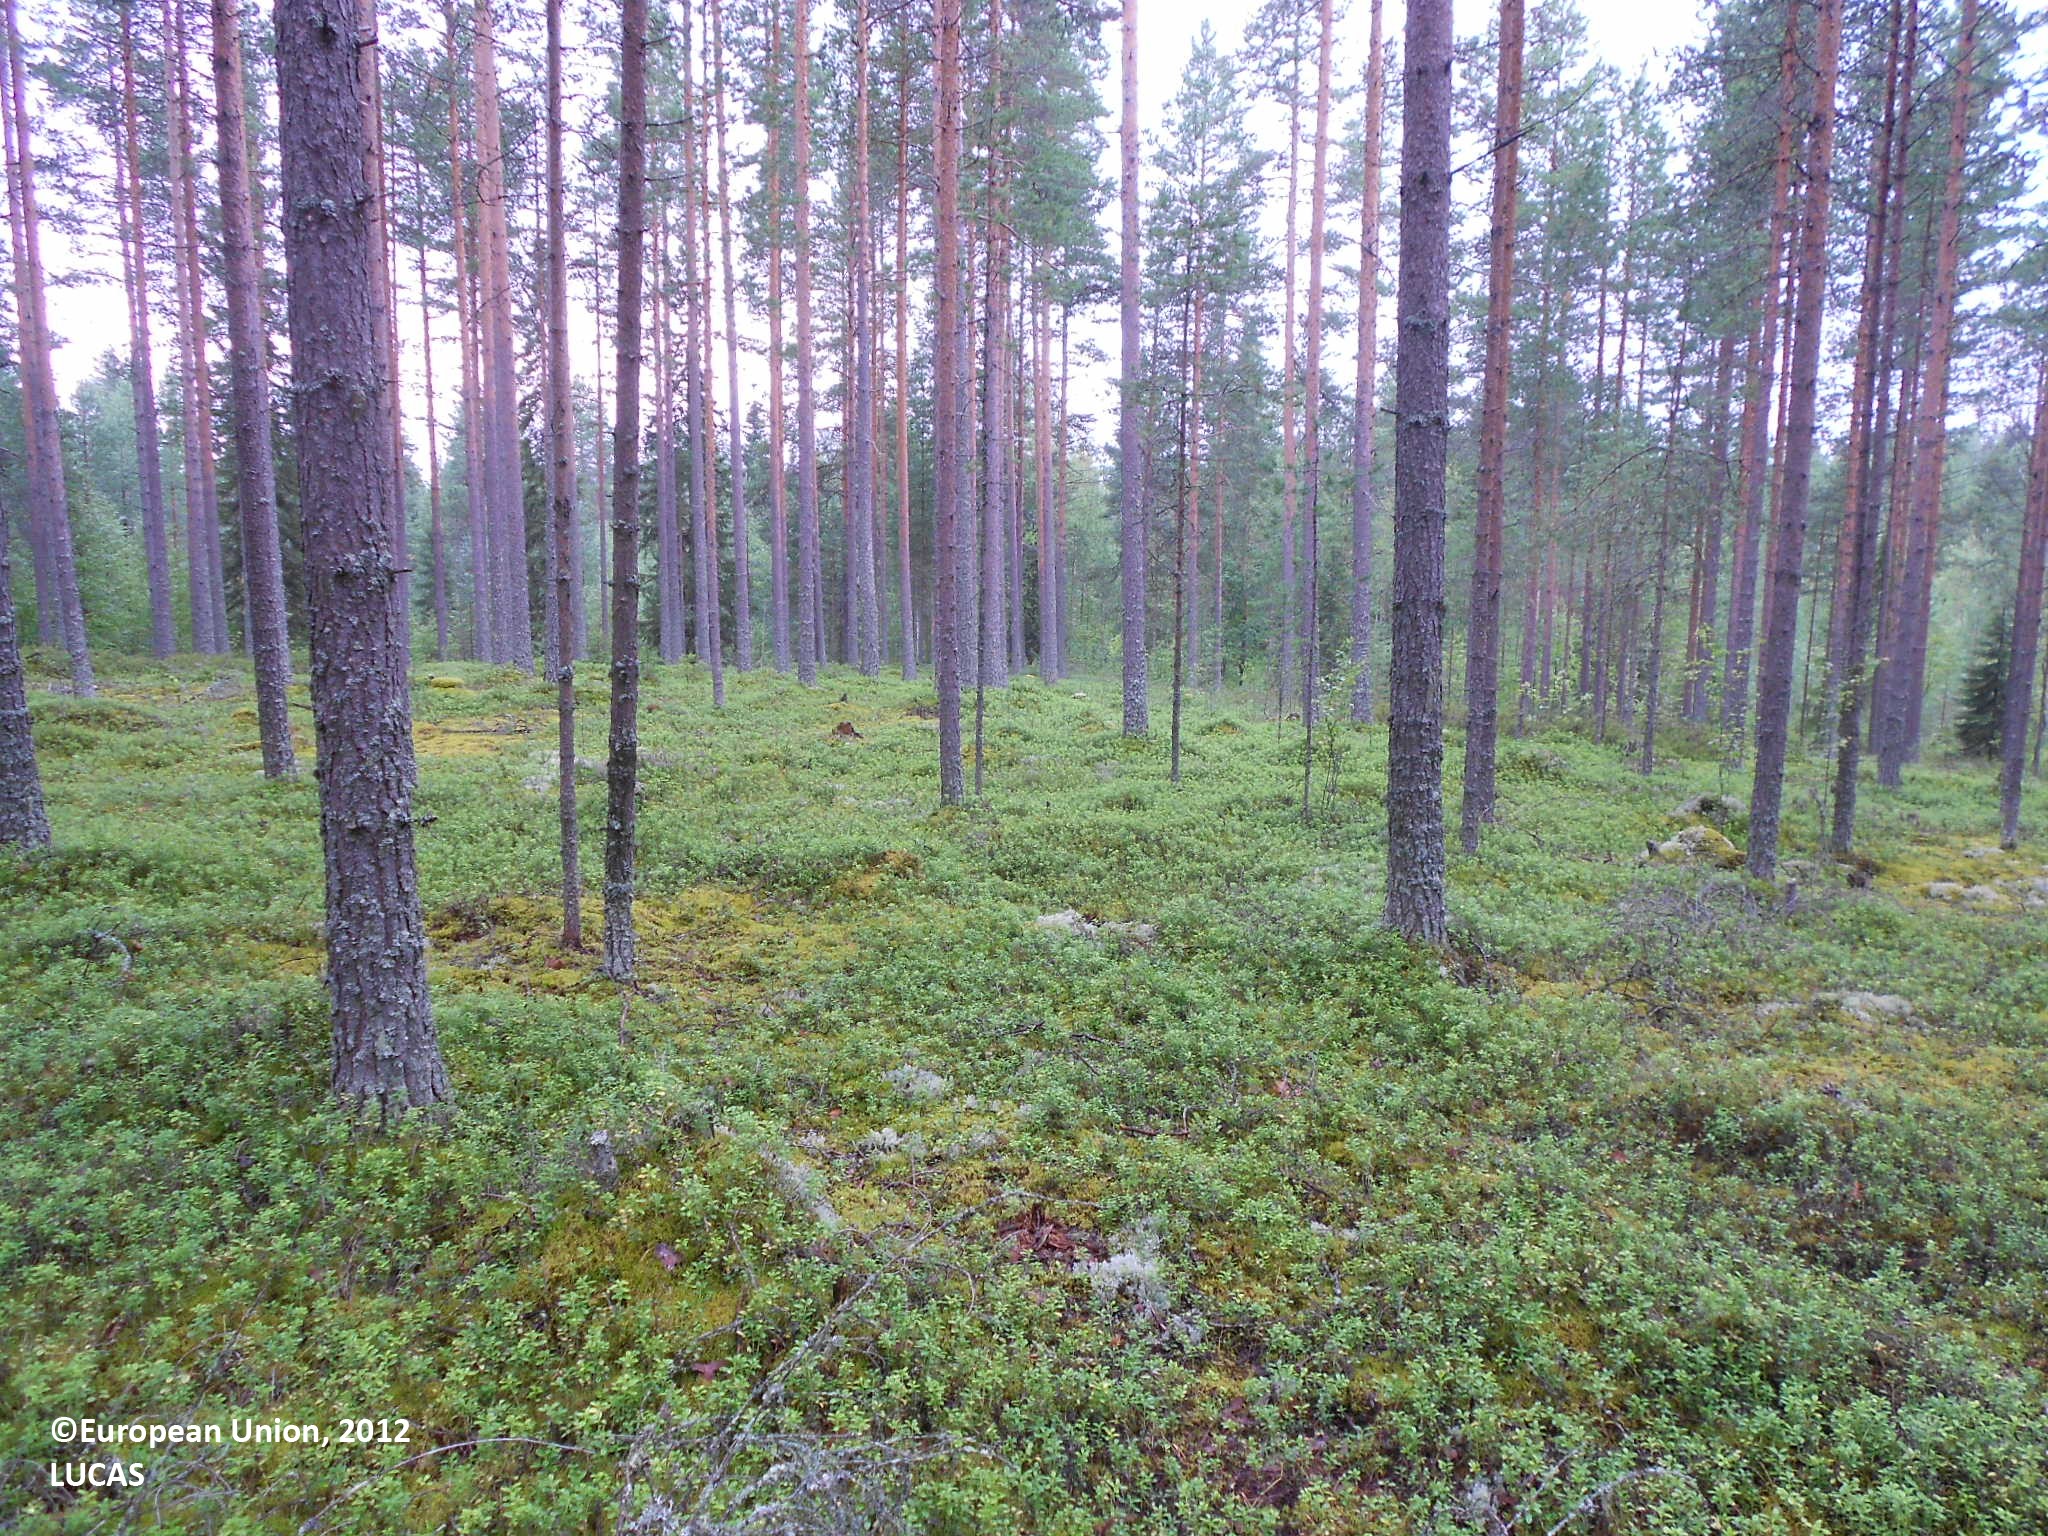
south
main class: Woodland
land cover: Pine dominated coniferous woodland
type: boreal forest
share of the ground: 50 - 75 %
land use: Forestry
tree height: > 5 m
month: August
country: FI
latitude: 63.5788
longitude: 28.9166
